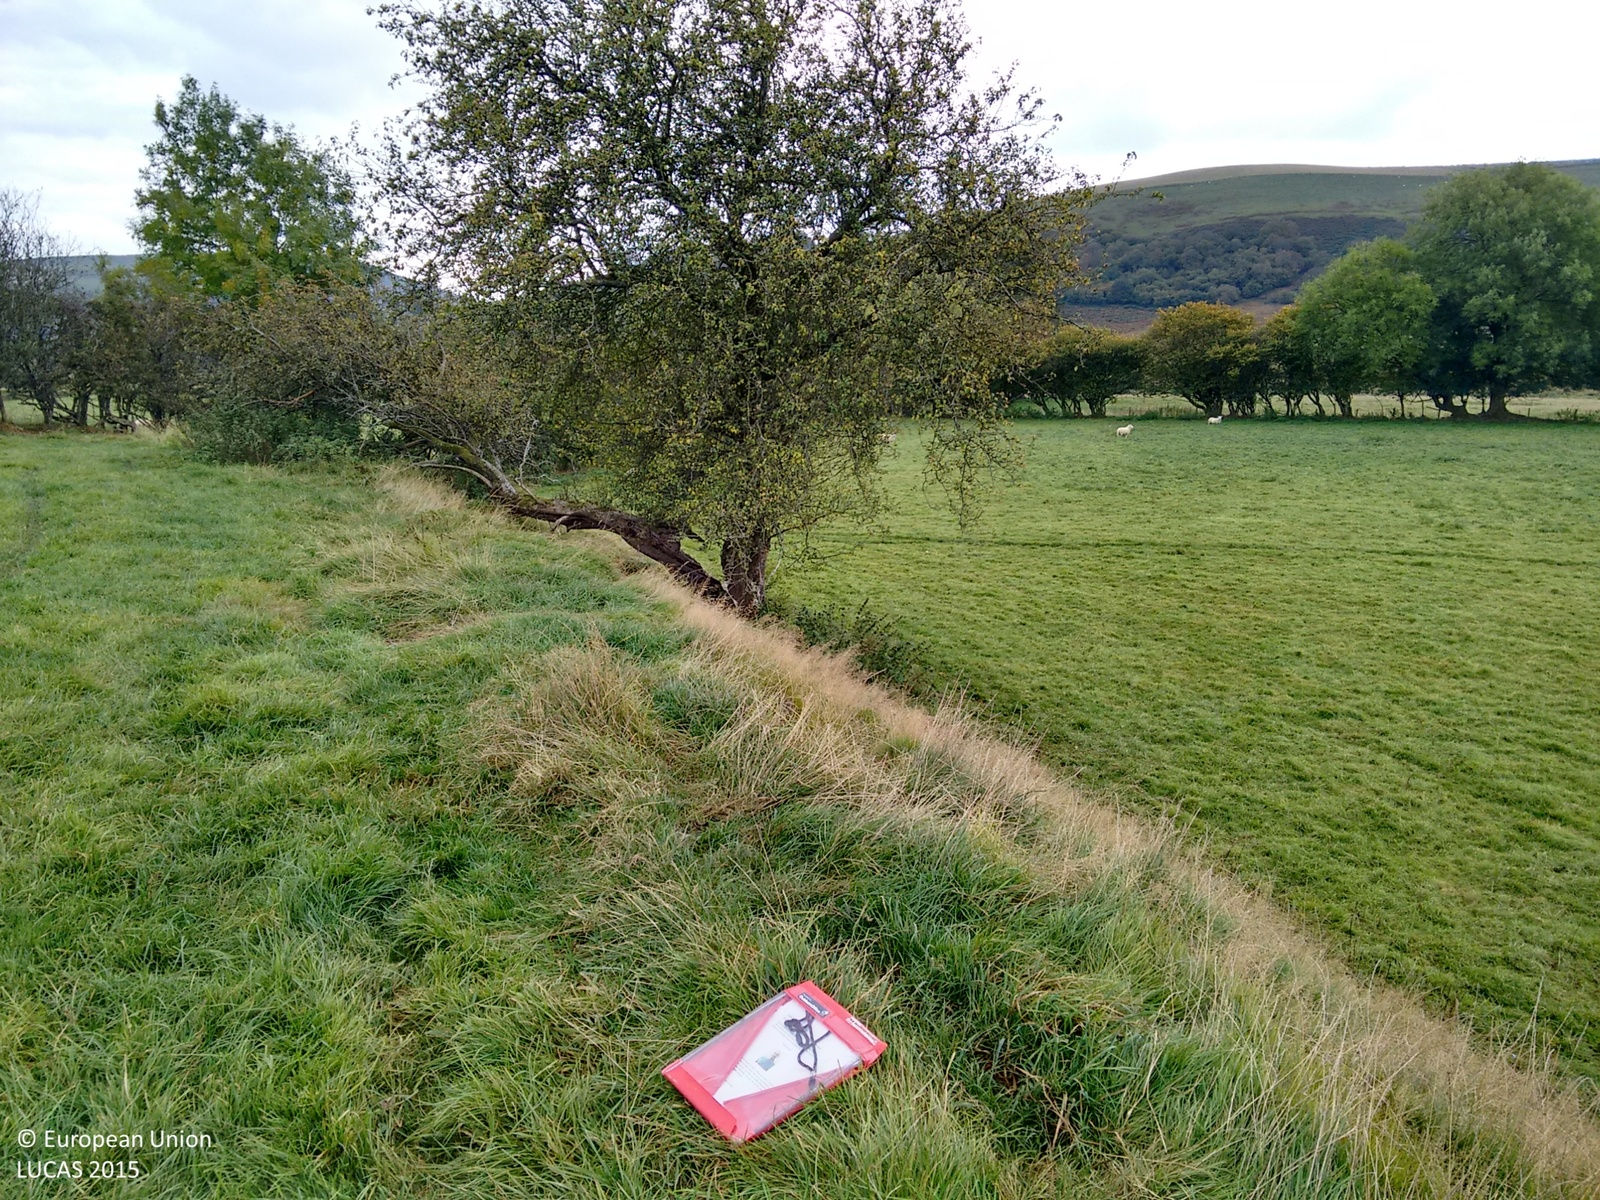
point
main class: Grassland
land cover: Grassland without tree/shrub cover
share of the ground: > 75 %
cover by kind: herbaceous plants 100 %
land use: Agriculture (excluding fallow land and kitchen gardens)
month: October
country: GB
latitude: 52.4080
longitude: -3.6256
